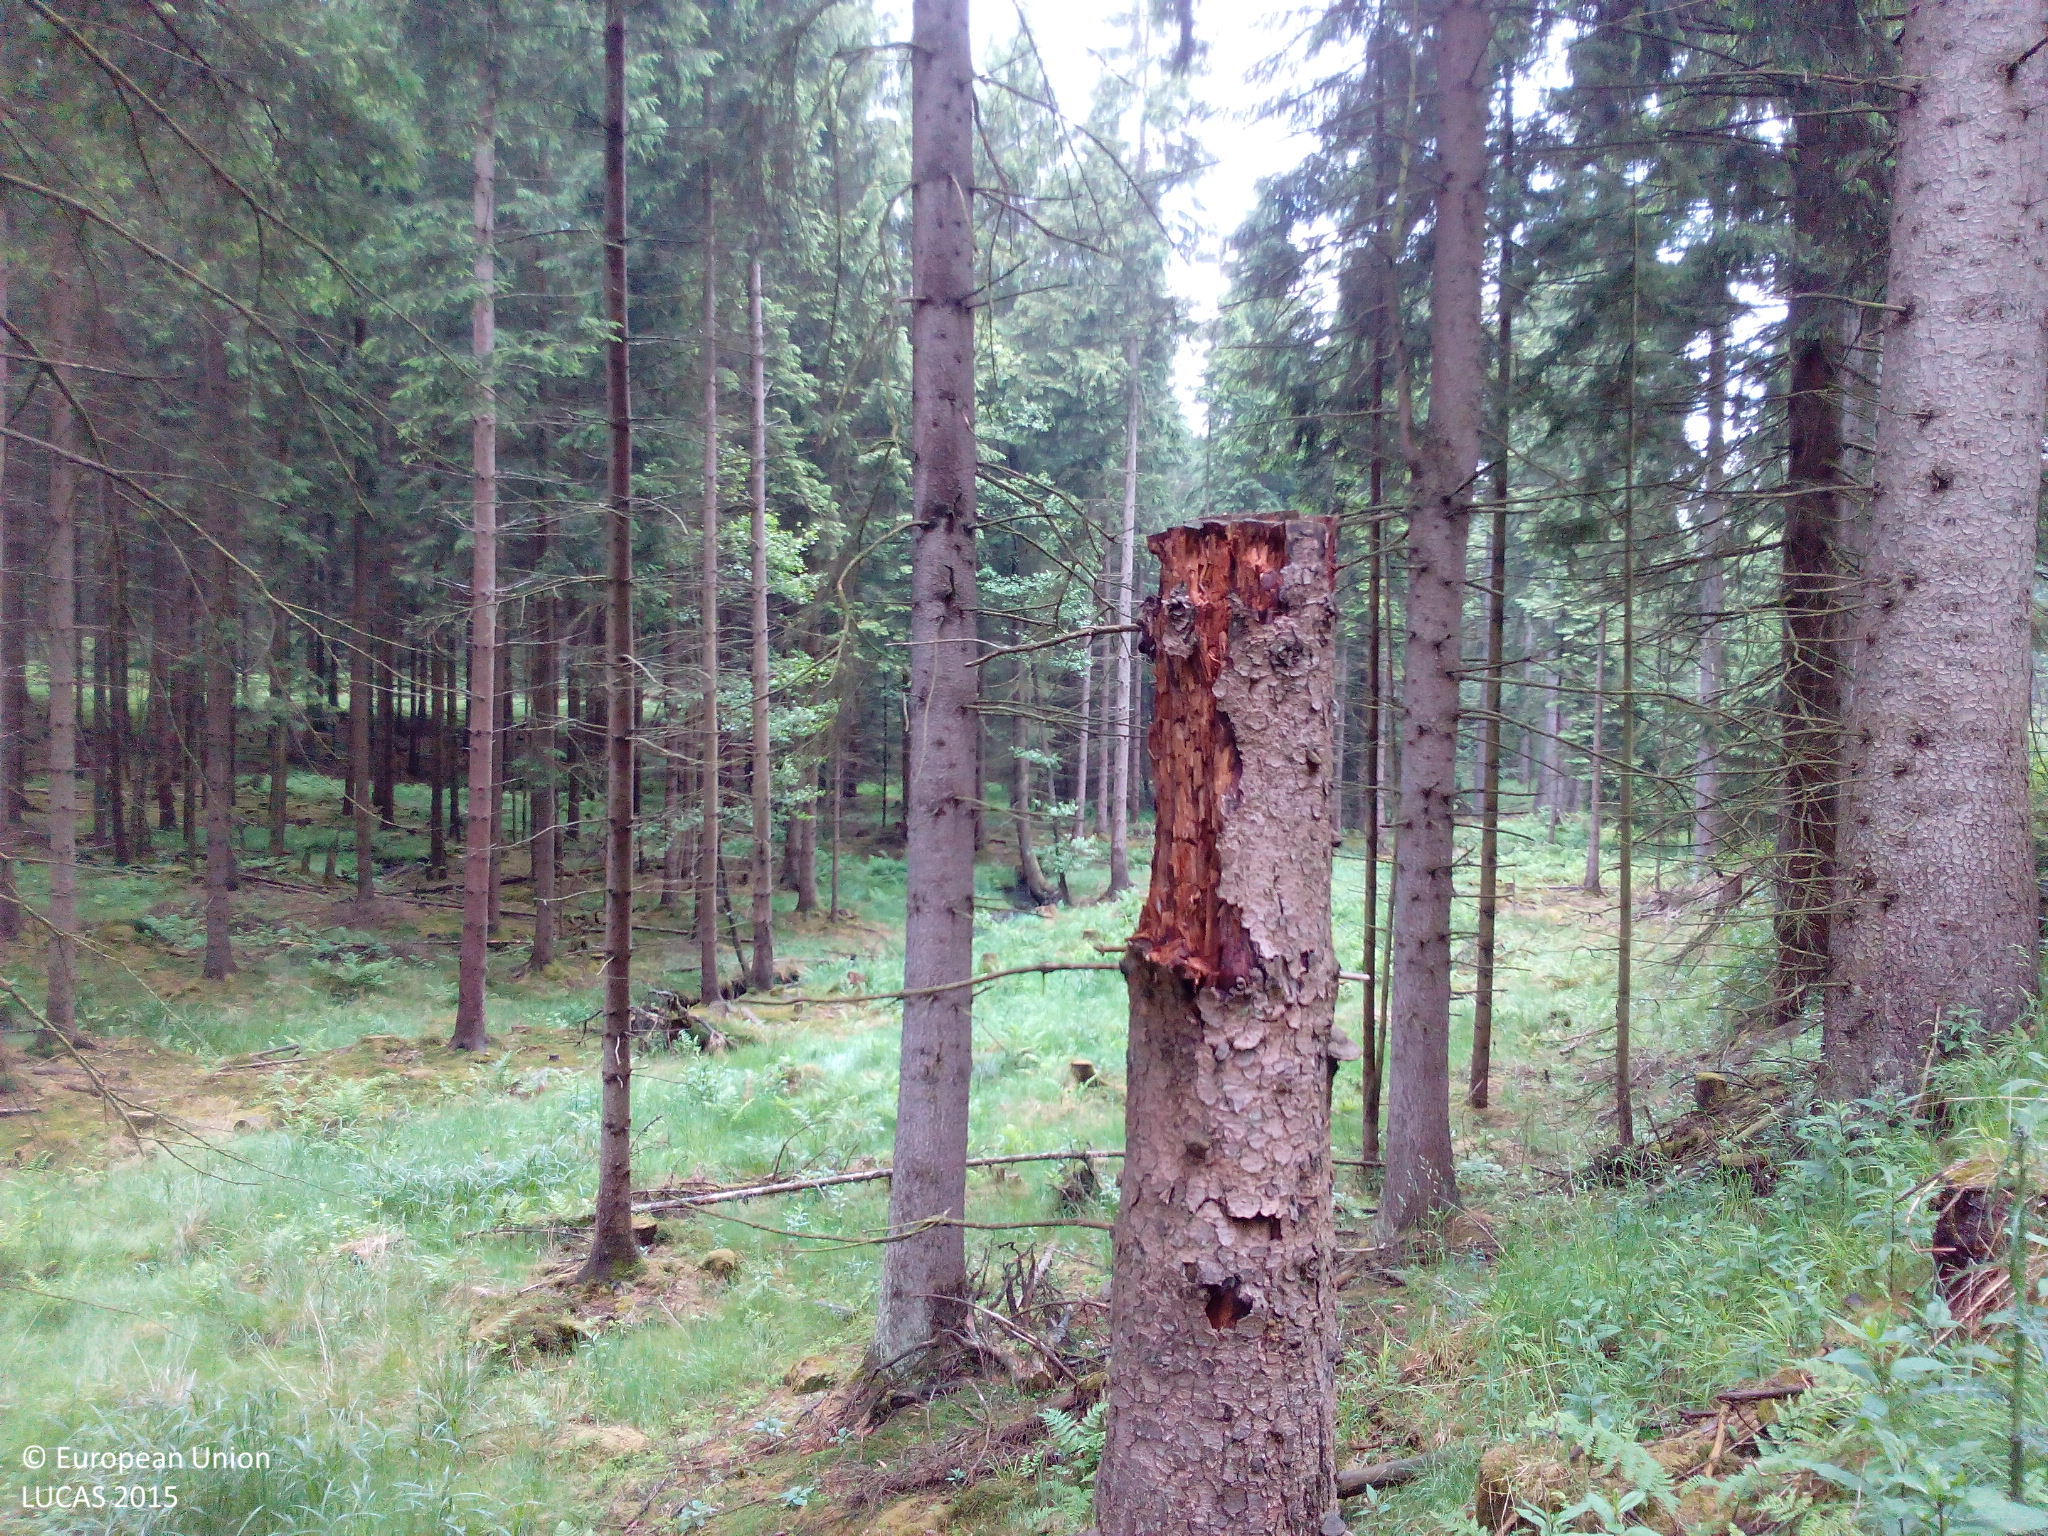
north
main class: Woodland
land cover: Spruce dominated coniferous woodland
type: hemiboreal forest and nemoral coniferous forest and mixed broadleaved-coniferous forest
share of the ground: > 75 %
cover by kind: coniferous forest trees 95 %, broadleaved forest trees 5 %
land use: Forestry
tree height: > 5 m
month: June
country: DE
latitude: 51.4700
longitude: 8.5752
